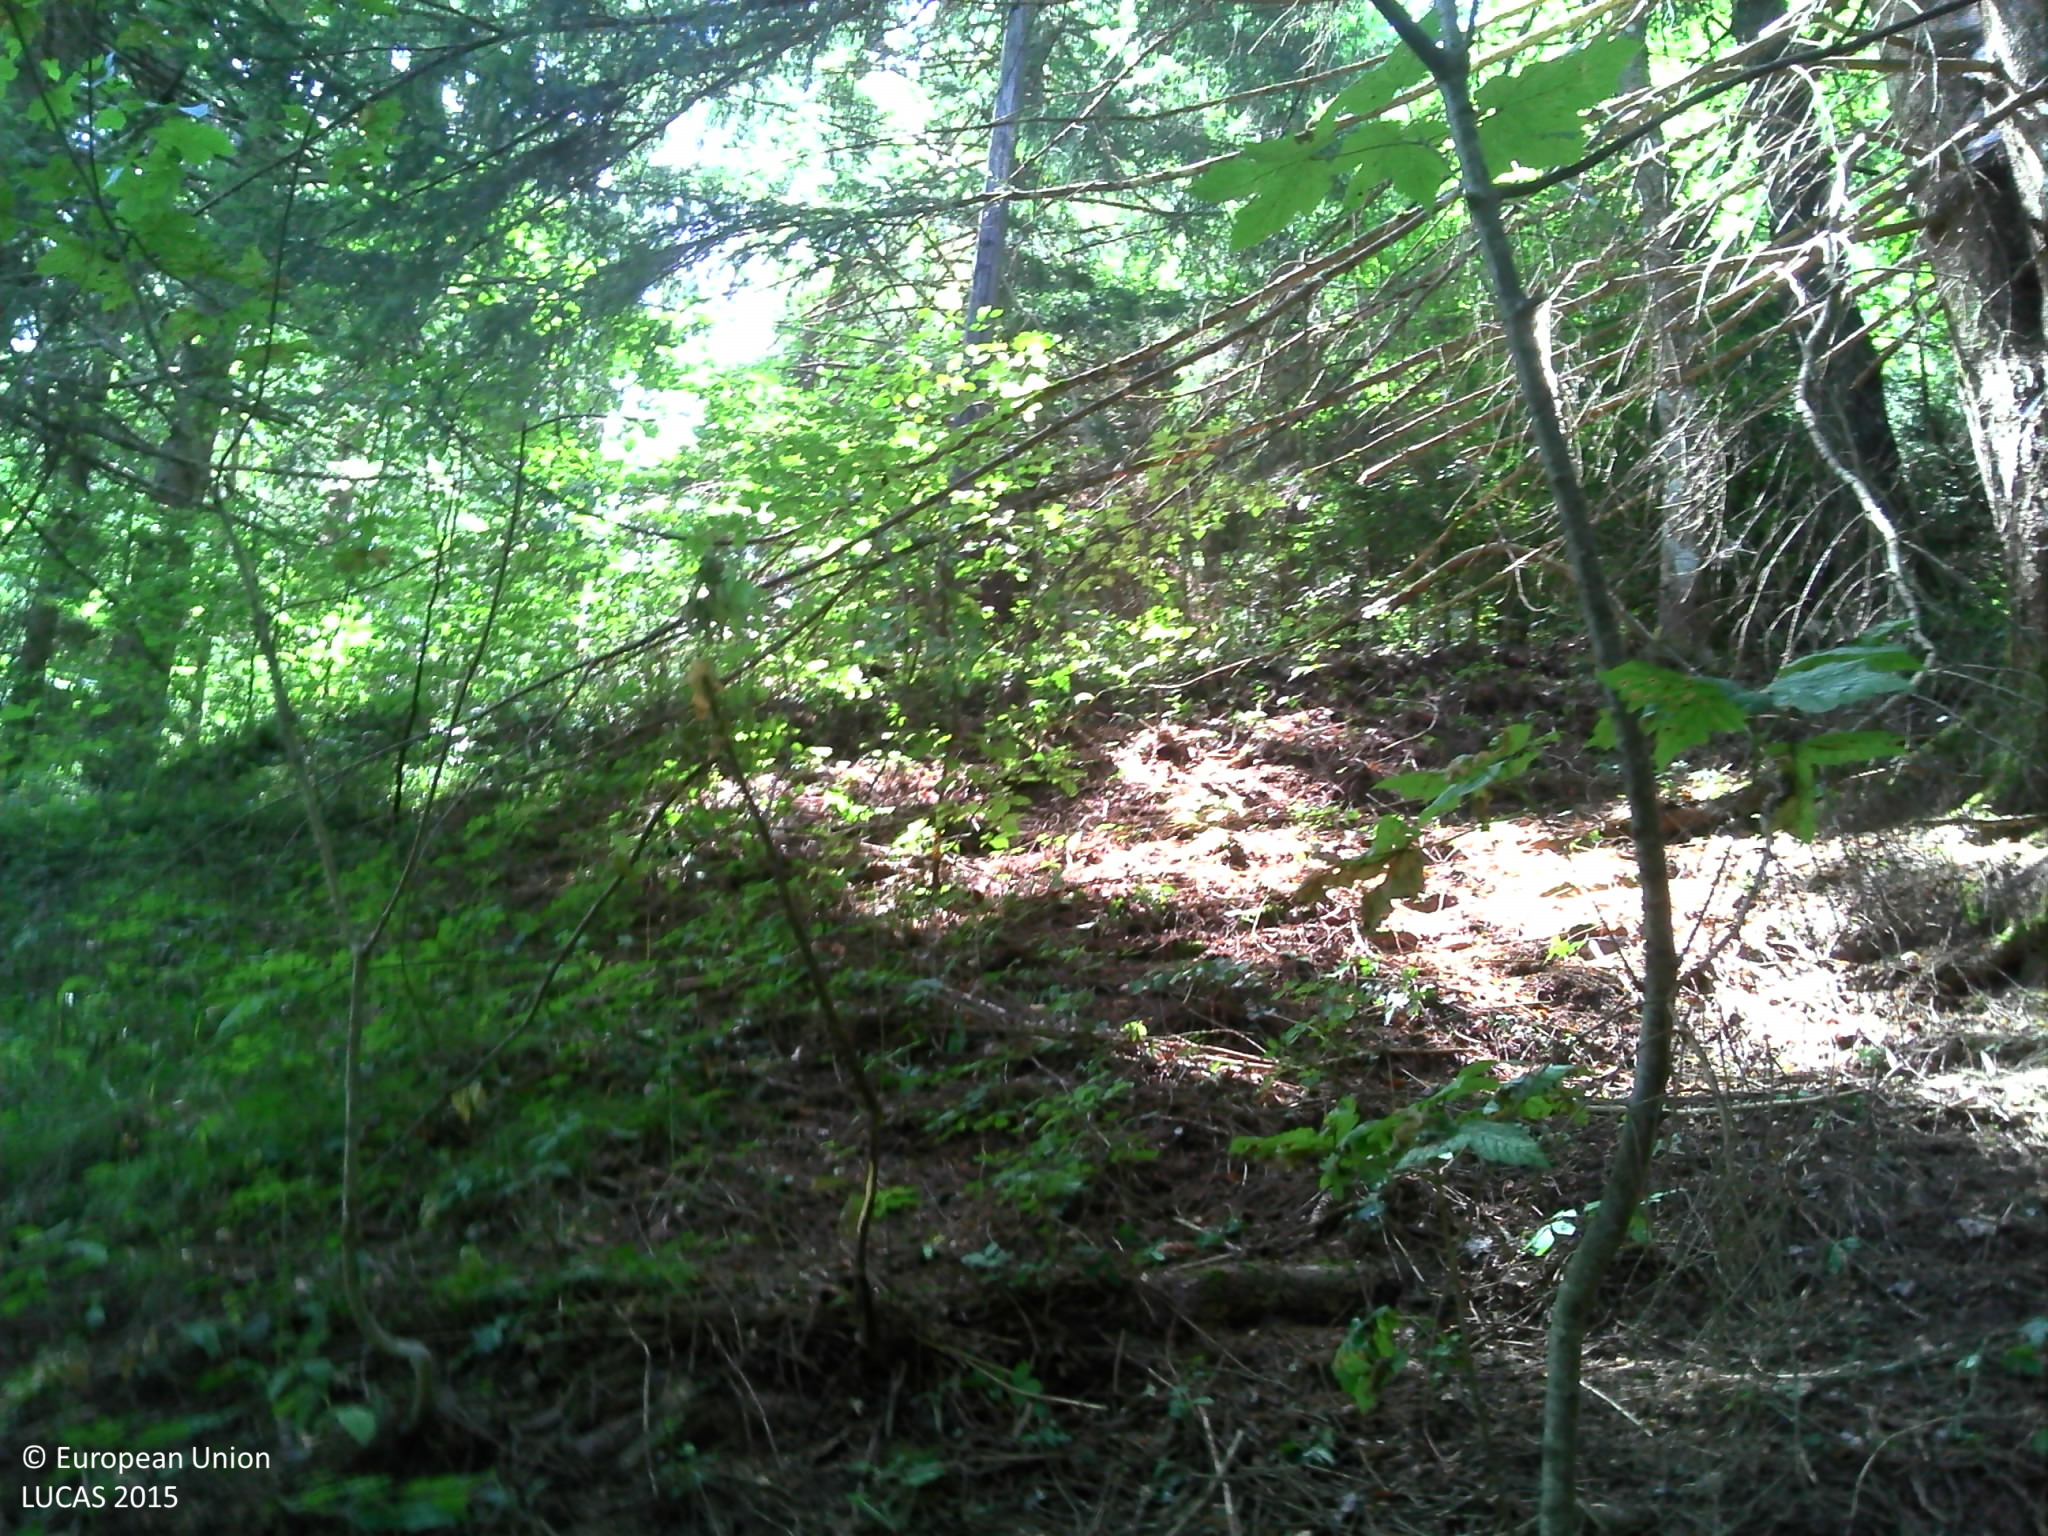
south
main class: Woodland
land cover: Spruce dominated coniferous woodland
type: alpine coniferous forest
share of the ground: > 75 %
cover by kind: coniferous forest trees 70 %, broadleaved forest trees 15 %, herbaceous plants 10 %, lichens and mosses 5 %
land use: Forestry
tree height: > 5 m
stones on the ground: < 10 %
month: July
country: FR
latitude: 46.1667
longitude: 6.4678
